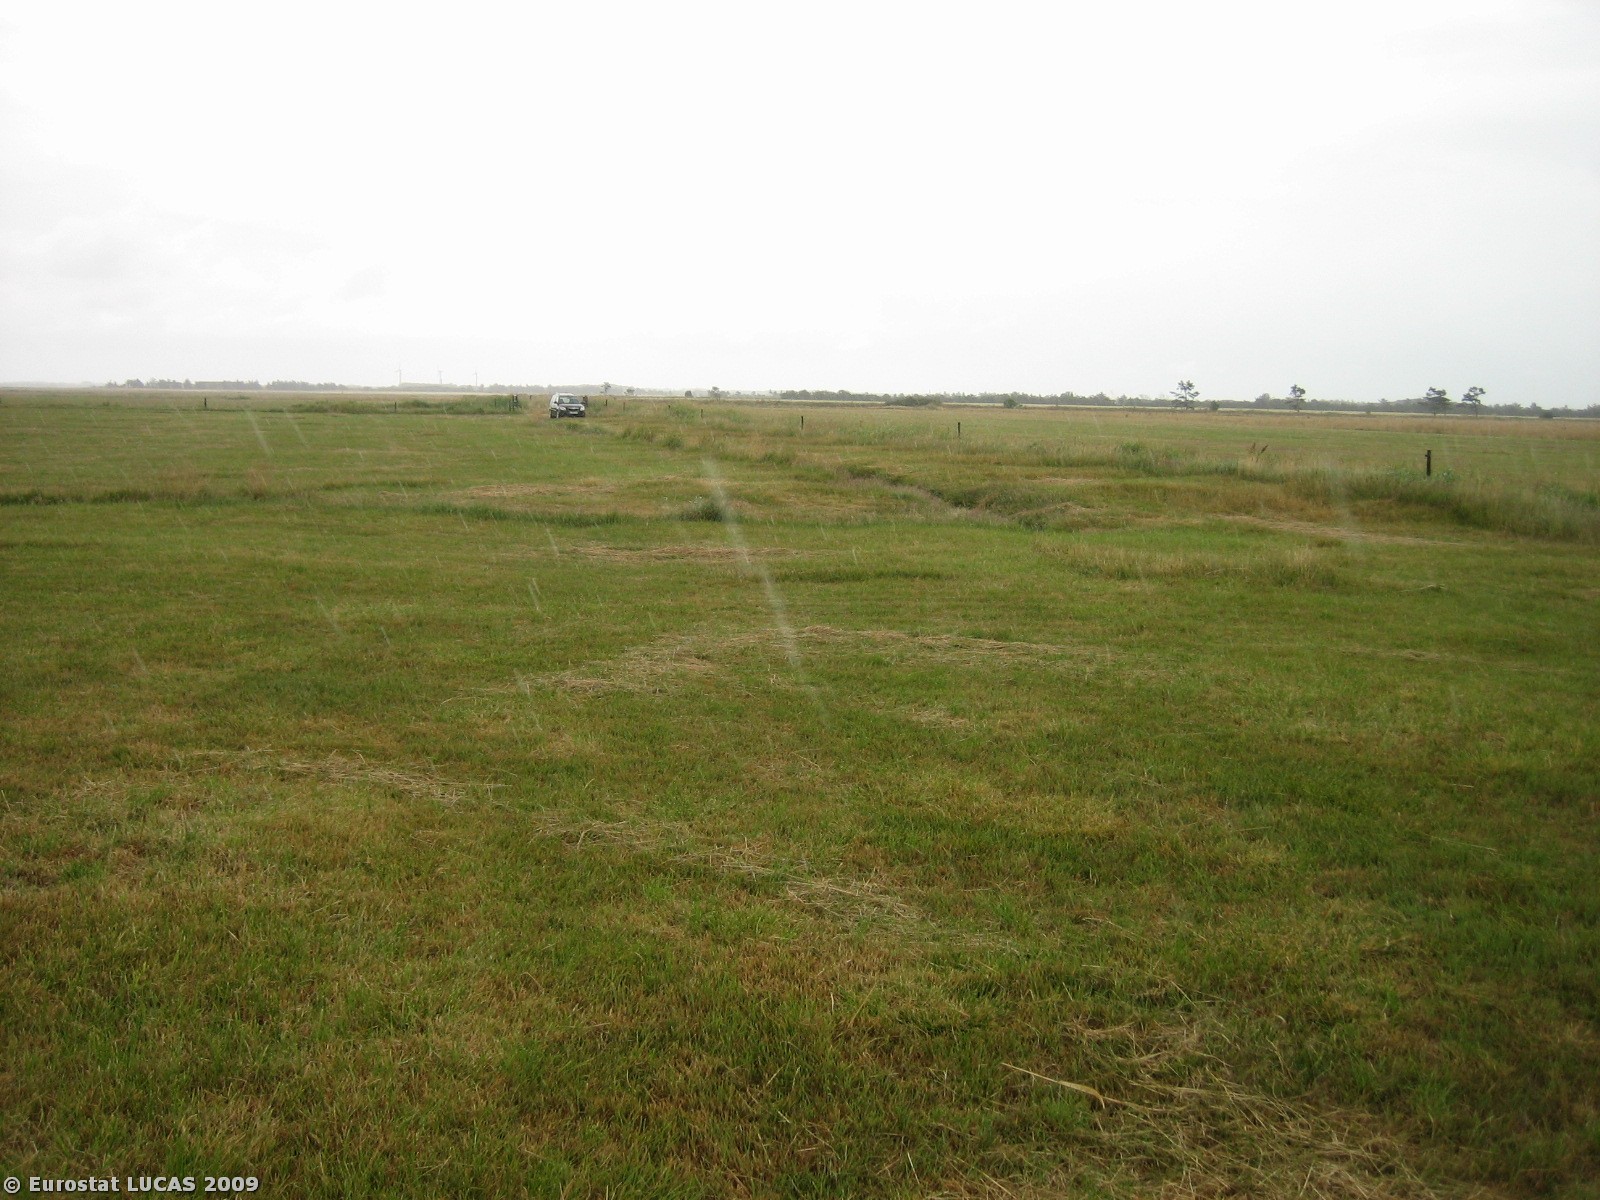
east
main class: Grassland
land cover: Grassland without tree/shrub cover
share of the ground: > 75 %
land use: Agriculture (excluding fallow land and kitchen gardens)
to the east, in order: Grassland without tree/shrub cover; Tracks; Grass margins; Ditches and canals; Fences; Grassland without tree/shrub cover; Fences; Grass margins; Tracks; Grass margins; Fences; Grassland without tree/shrub cover
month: July
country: DK
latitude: 55.6020
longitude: 8.3667
